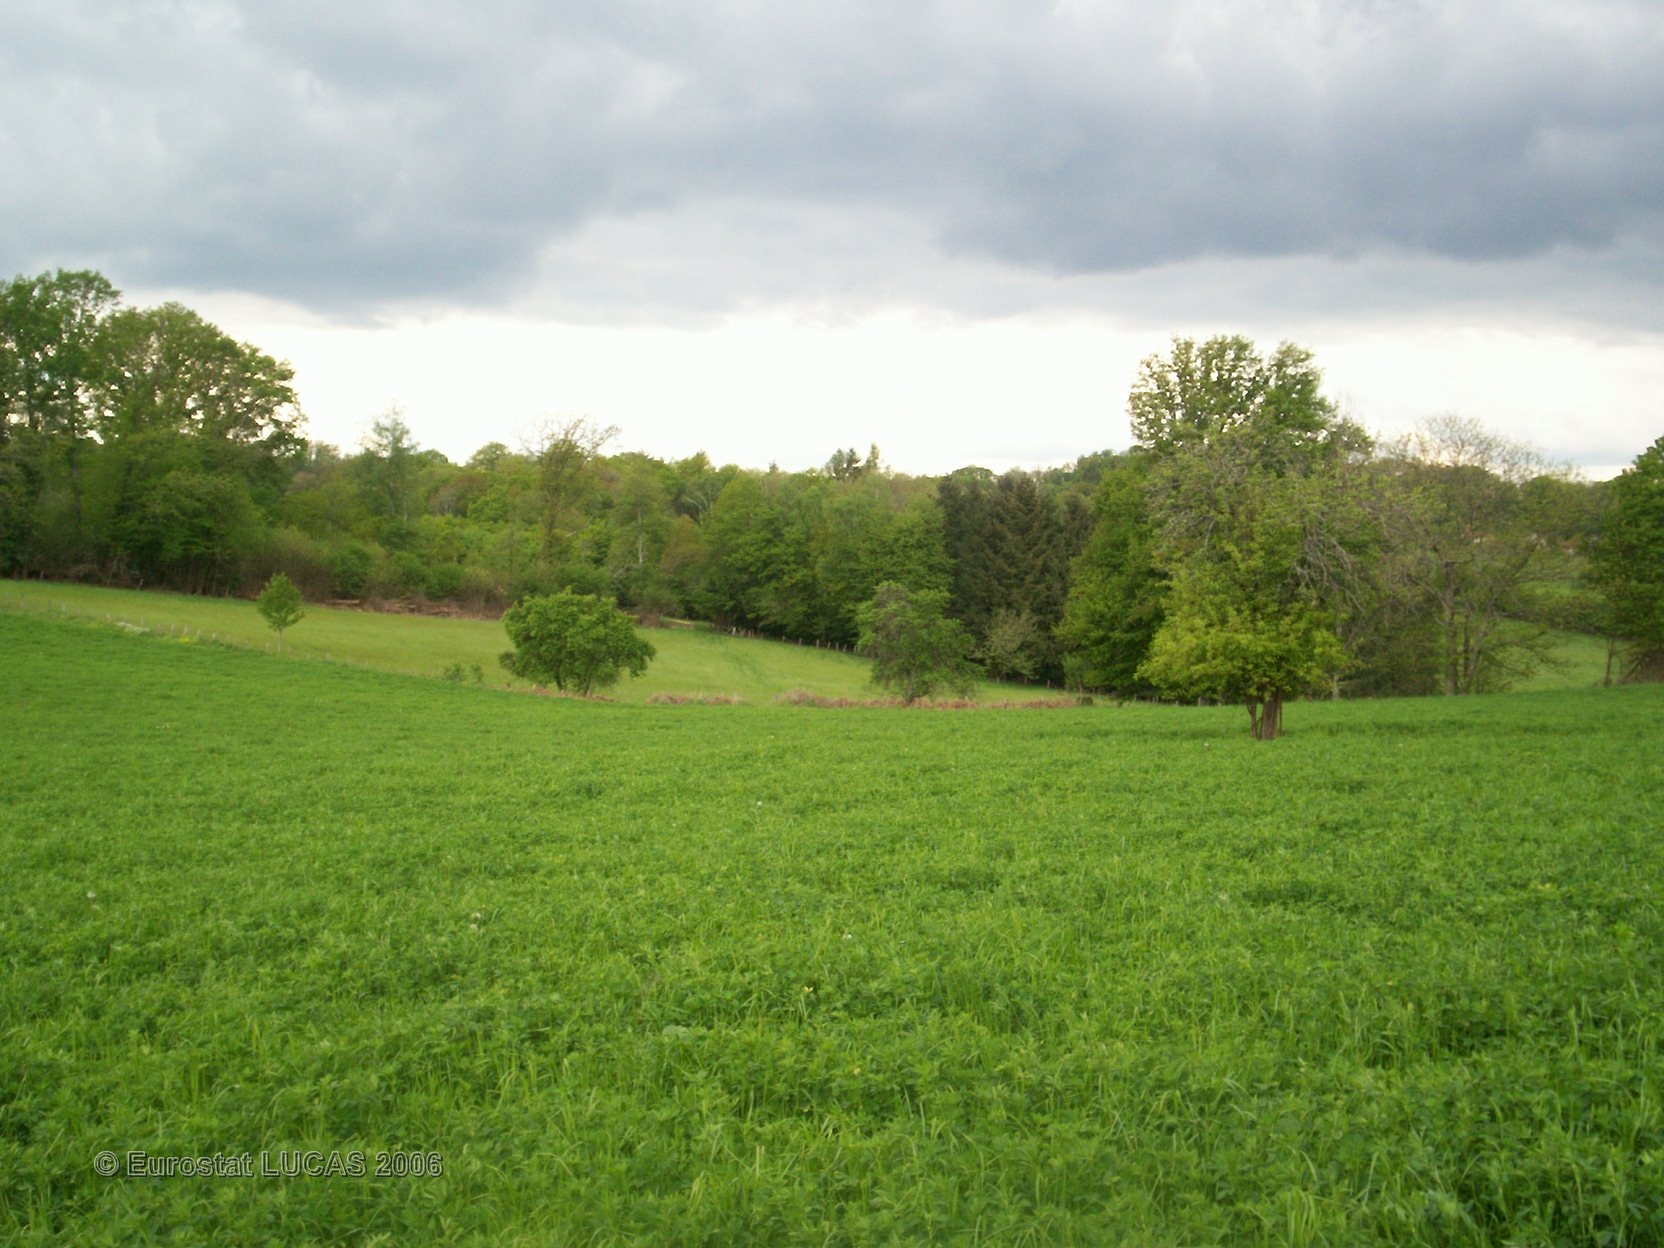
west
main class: Cropland
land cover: Lucerne
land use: Agriculture (excluding fallow land and kitchen gardens)
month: May
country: FR
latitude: 45.7446
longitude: 1.5482
